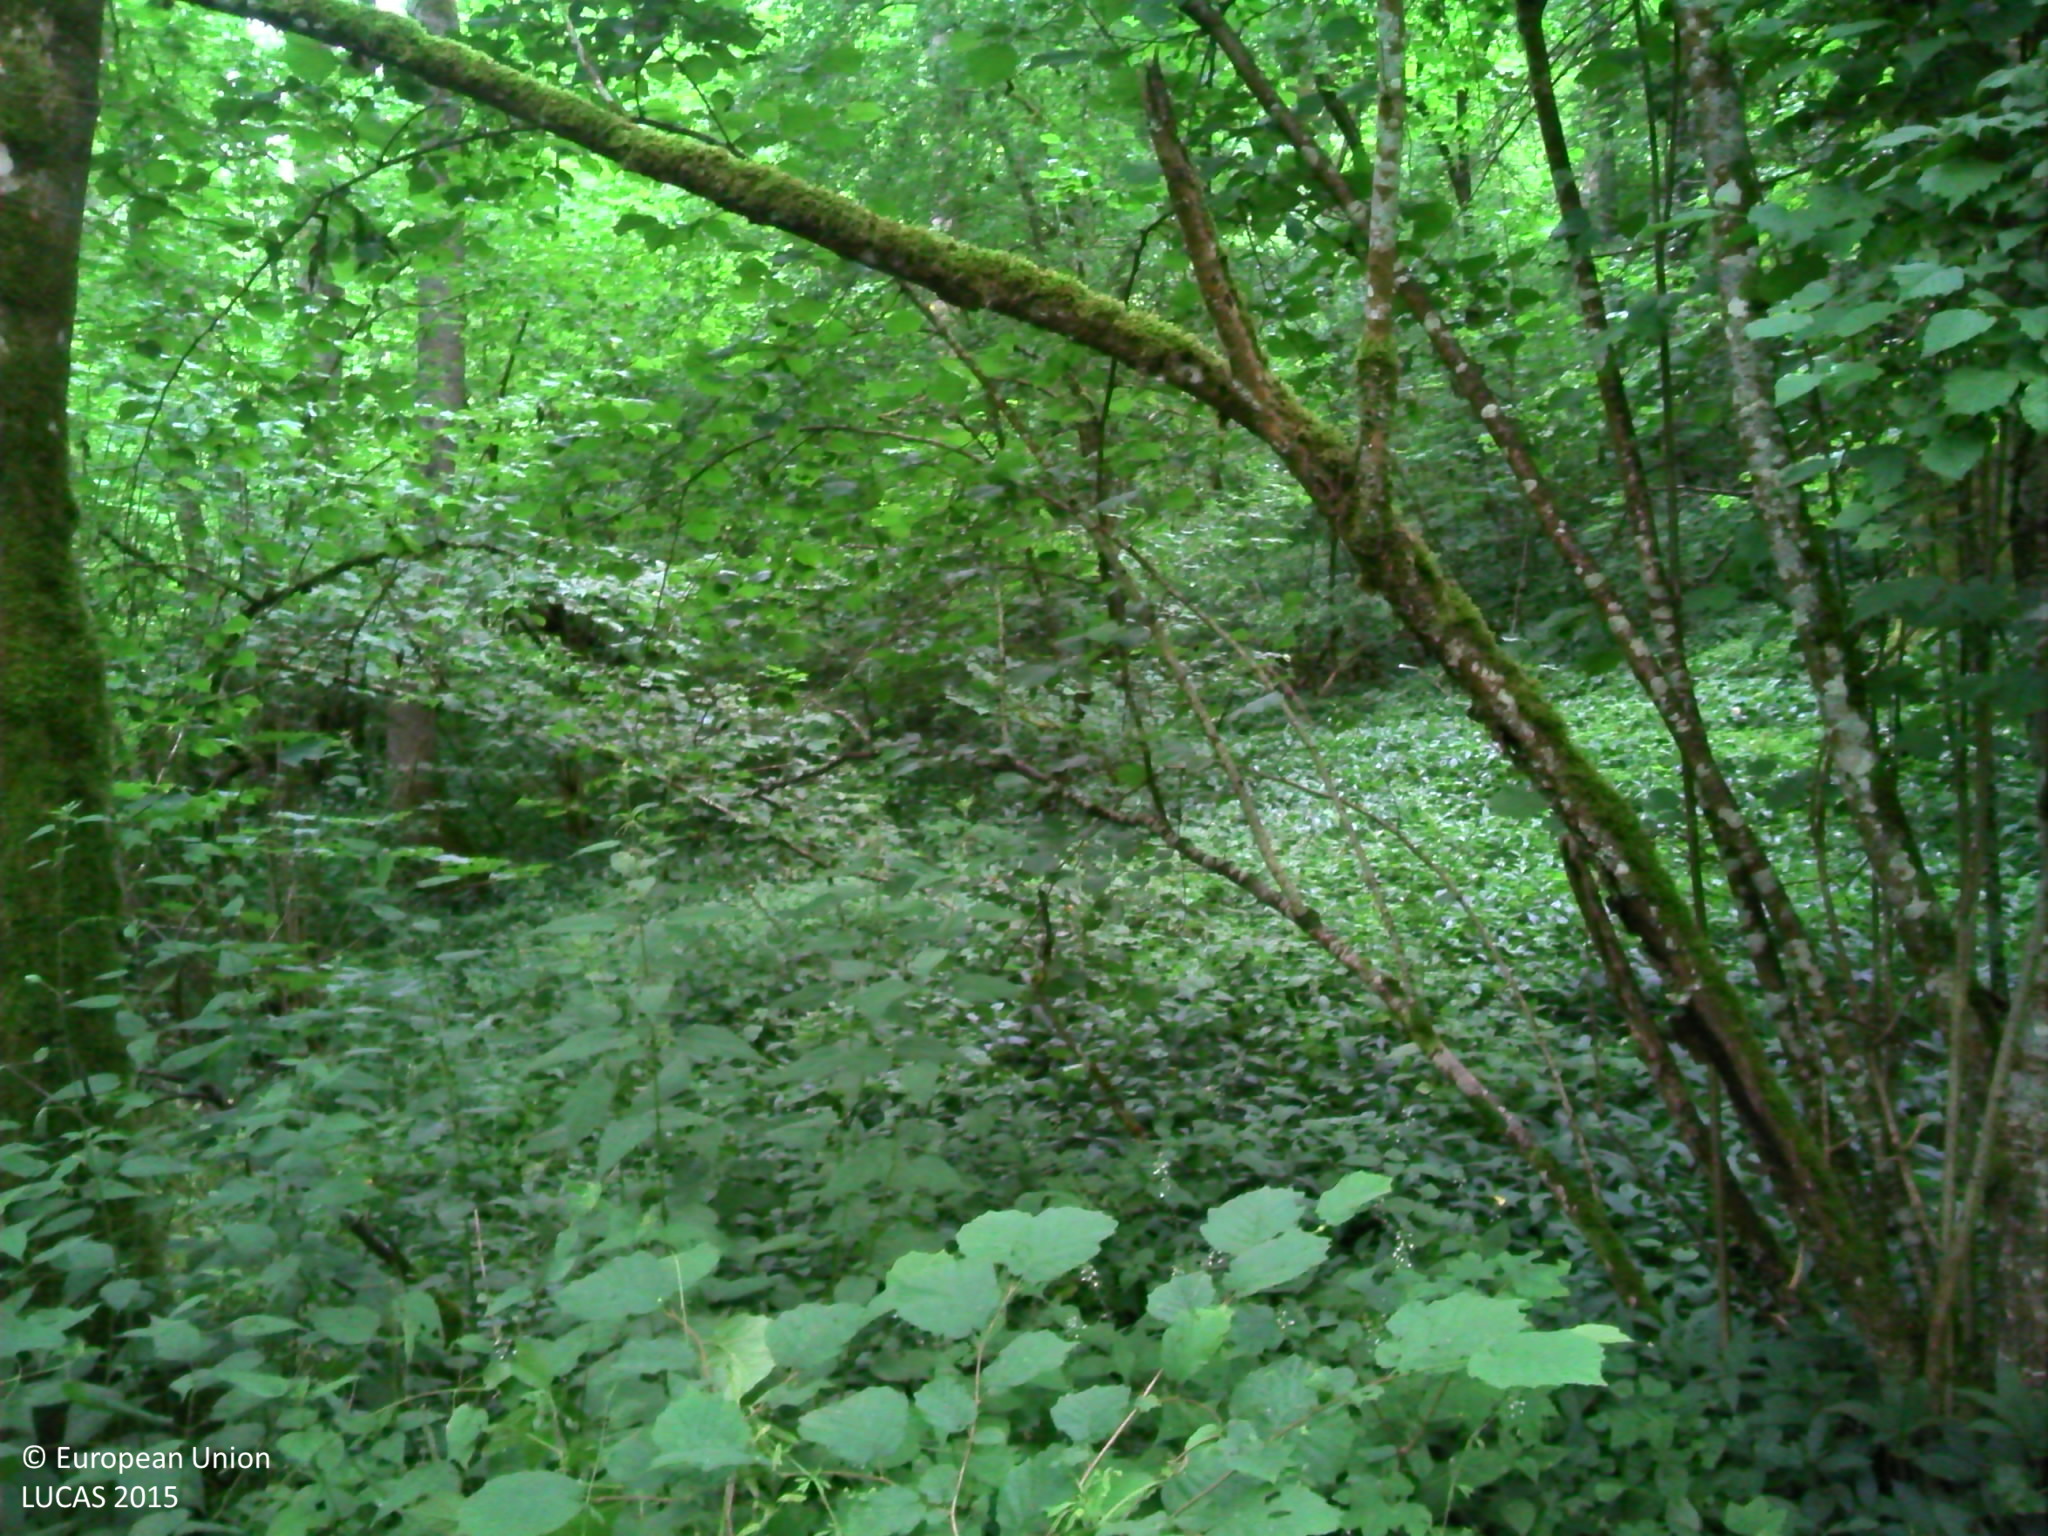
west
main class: Woodland
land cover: Broadleaved woodland
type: mesophytic deciduous forest
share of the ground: > 75 %
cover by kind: broadleaved forest trees 100 %
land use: Forestry
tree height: > 5 m
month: July
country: BE
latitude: 50.2032
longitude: 4.6584
